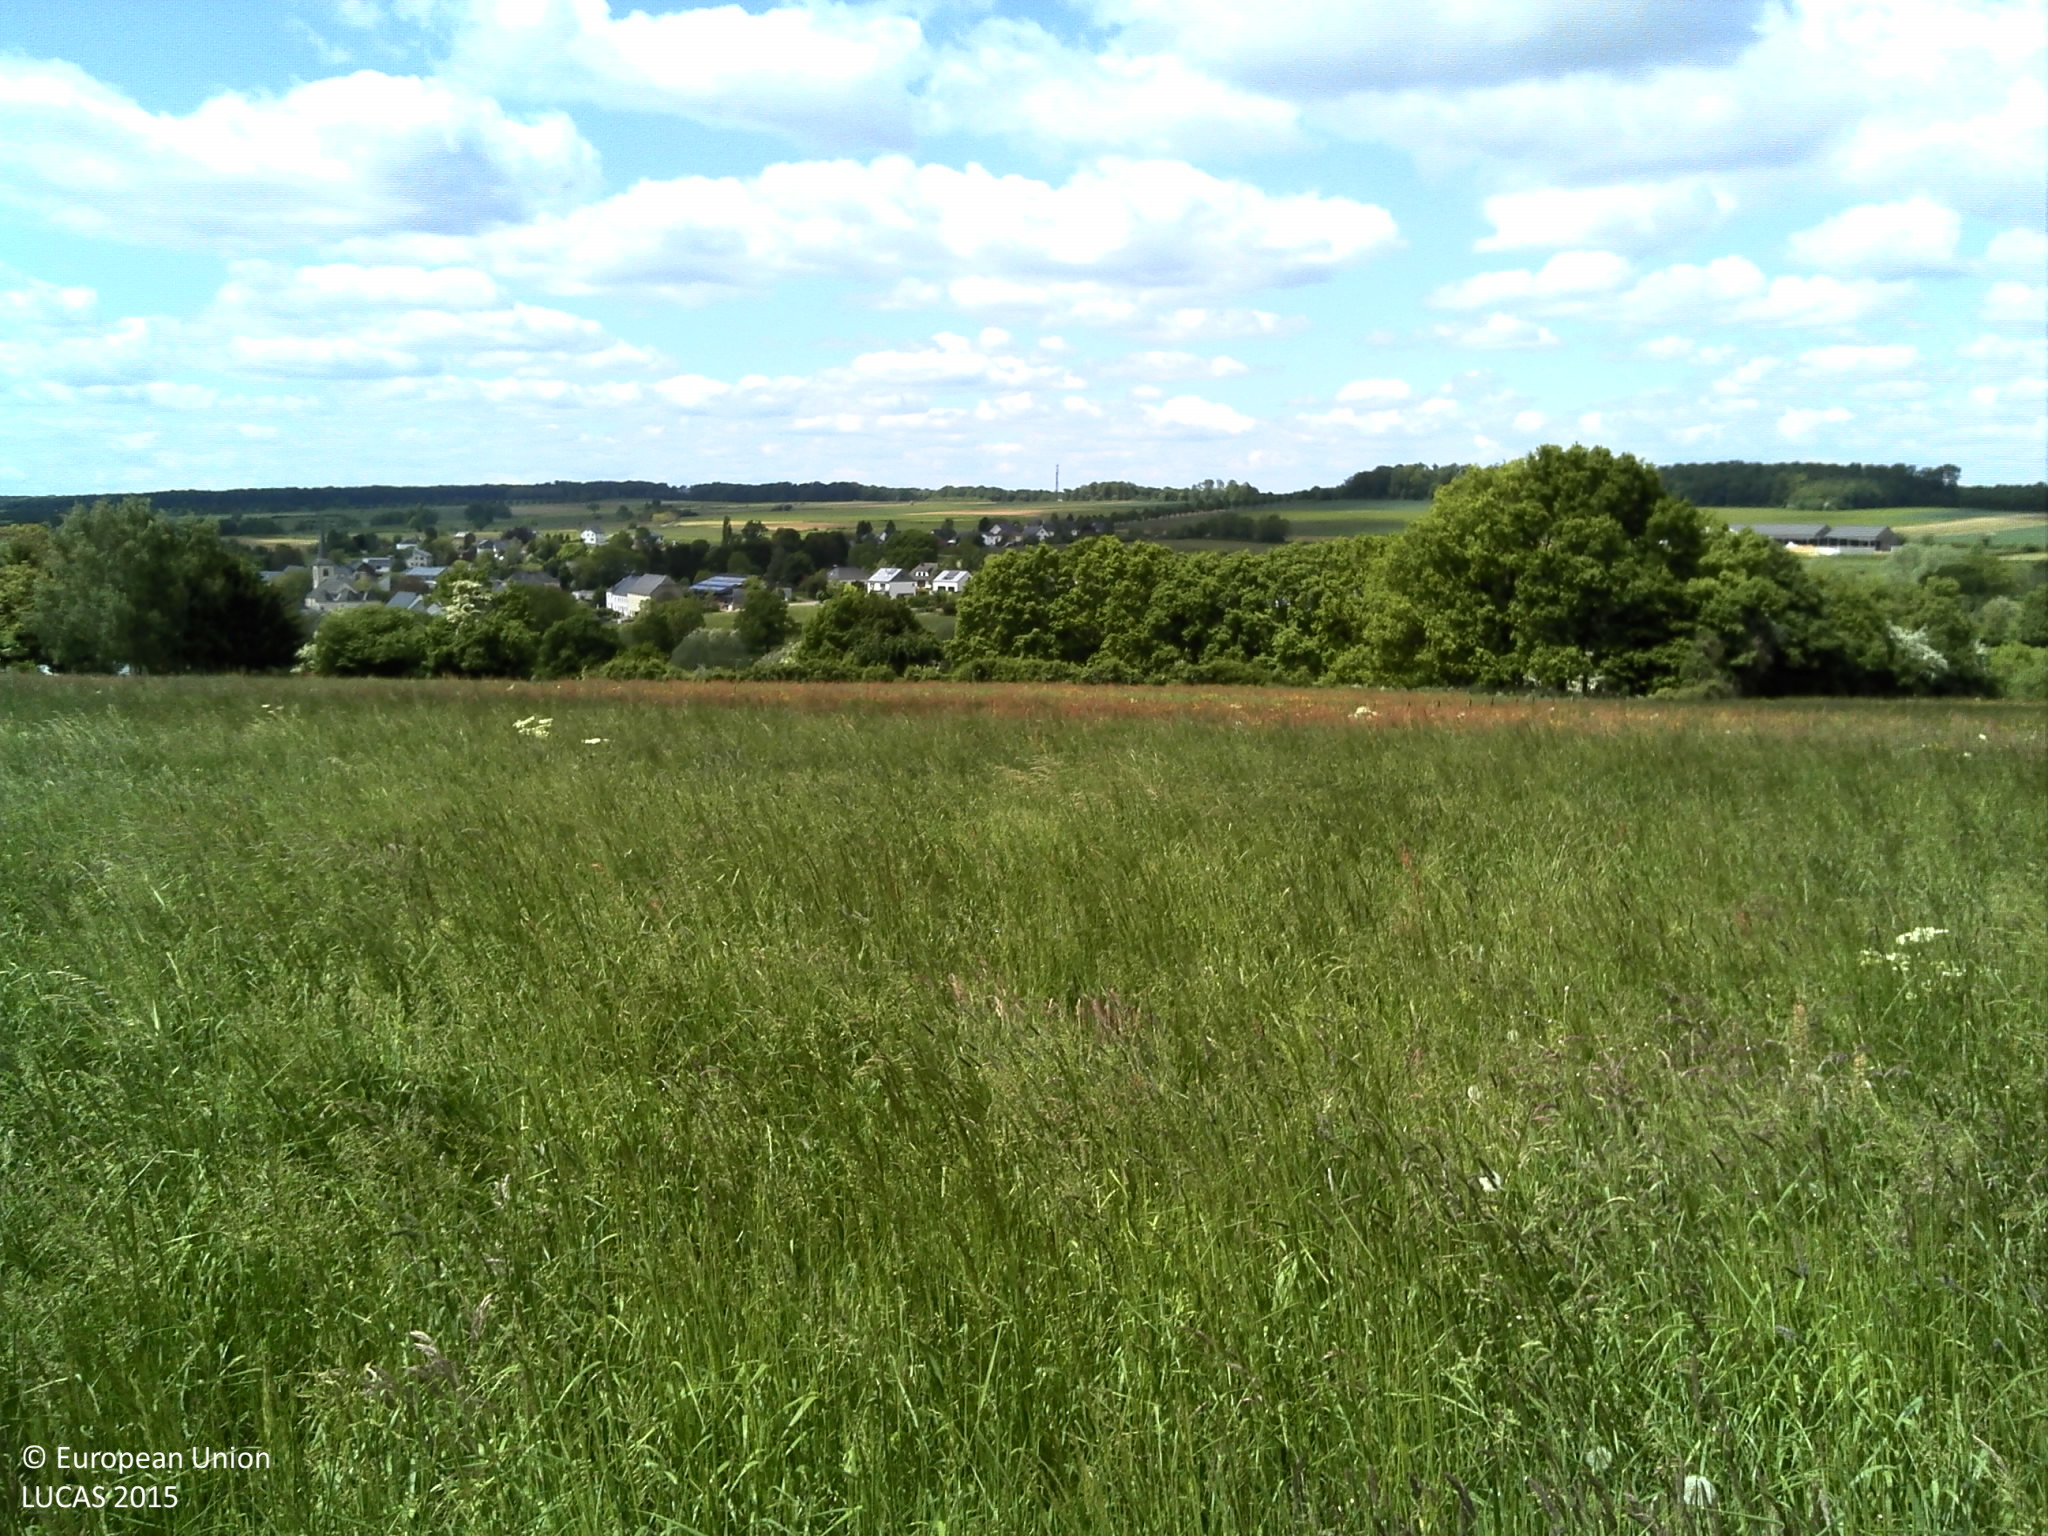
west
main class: Cropland
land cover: Temporary grasslands
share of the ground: > 75 %
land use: Agriculture (excluding fallow land and kitchen gardens)
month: May
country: LU
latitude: 49.7186
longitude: 6.0185
